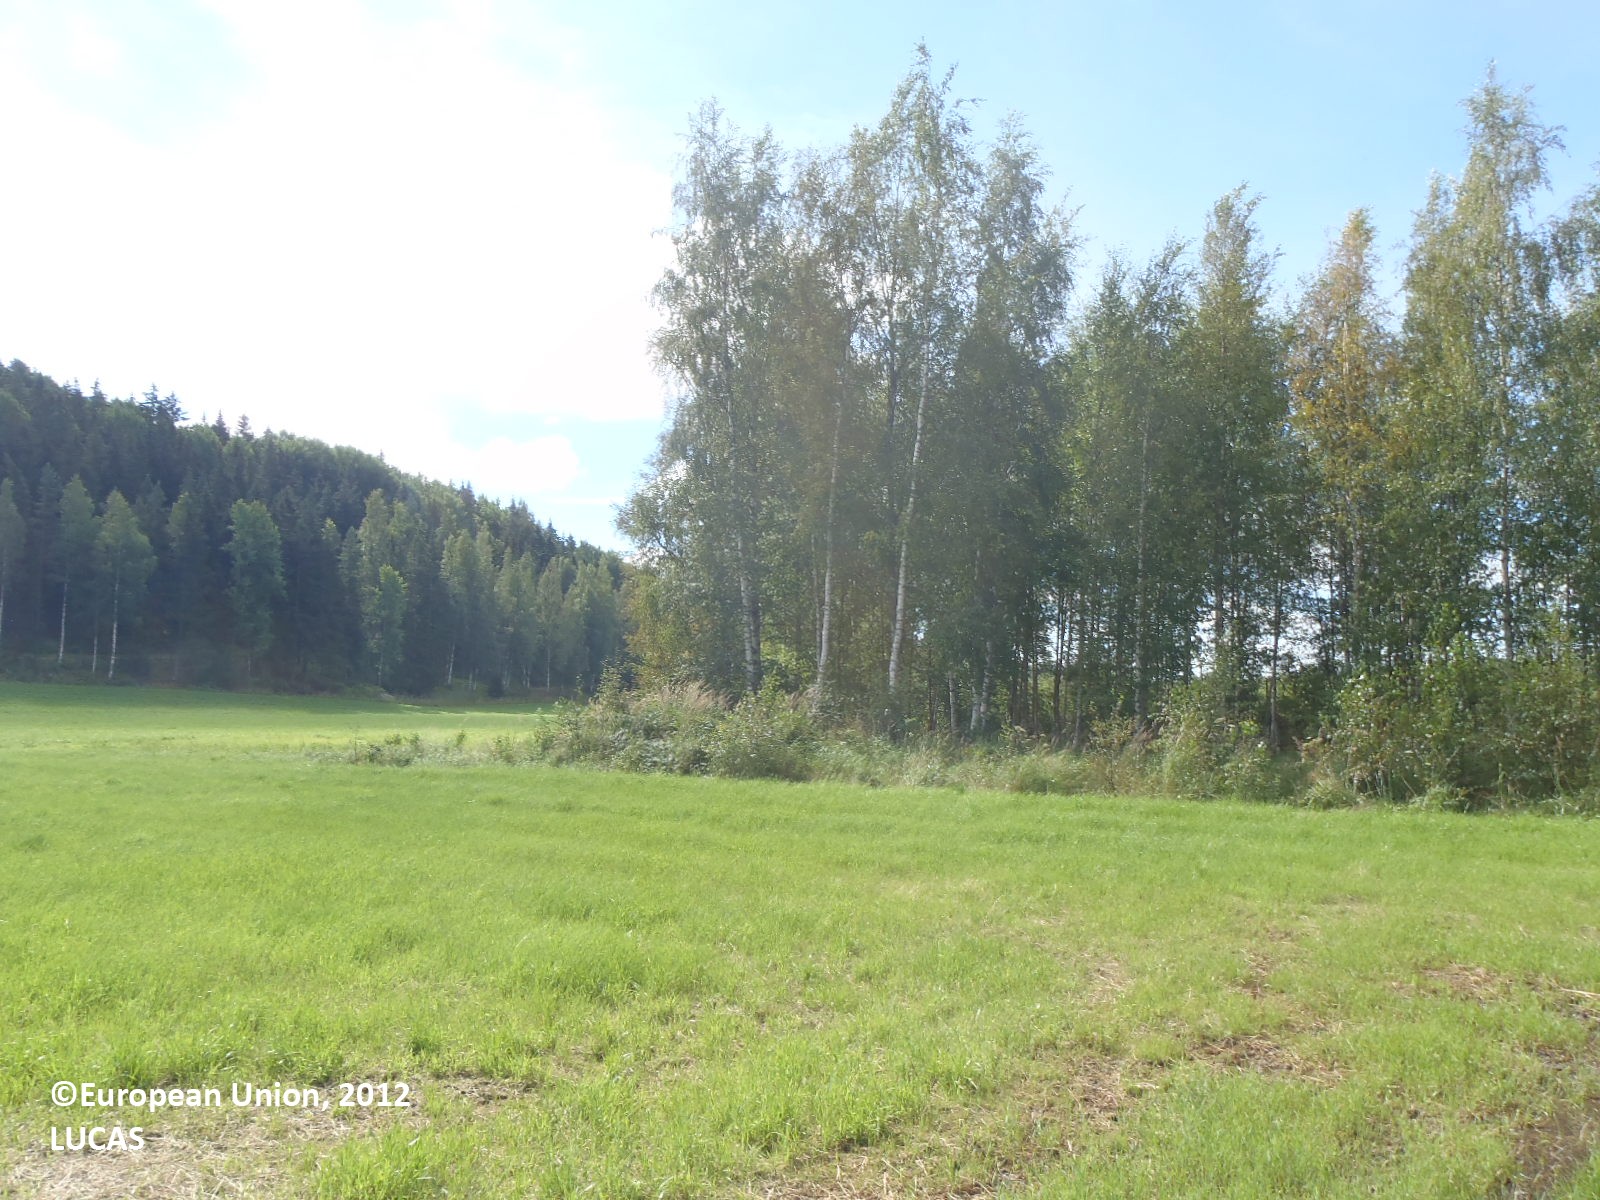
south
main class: Cropland
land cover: Temporary grasslands
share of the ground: > 75 %
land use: Agriculture (excluding fallow land and kitchen gardens)
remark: Harvested field
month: August
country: FI
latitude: 60.3953
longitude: 22.4279
